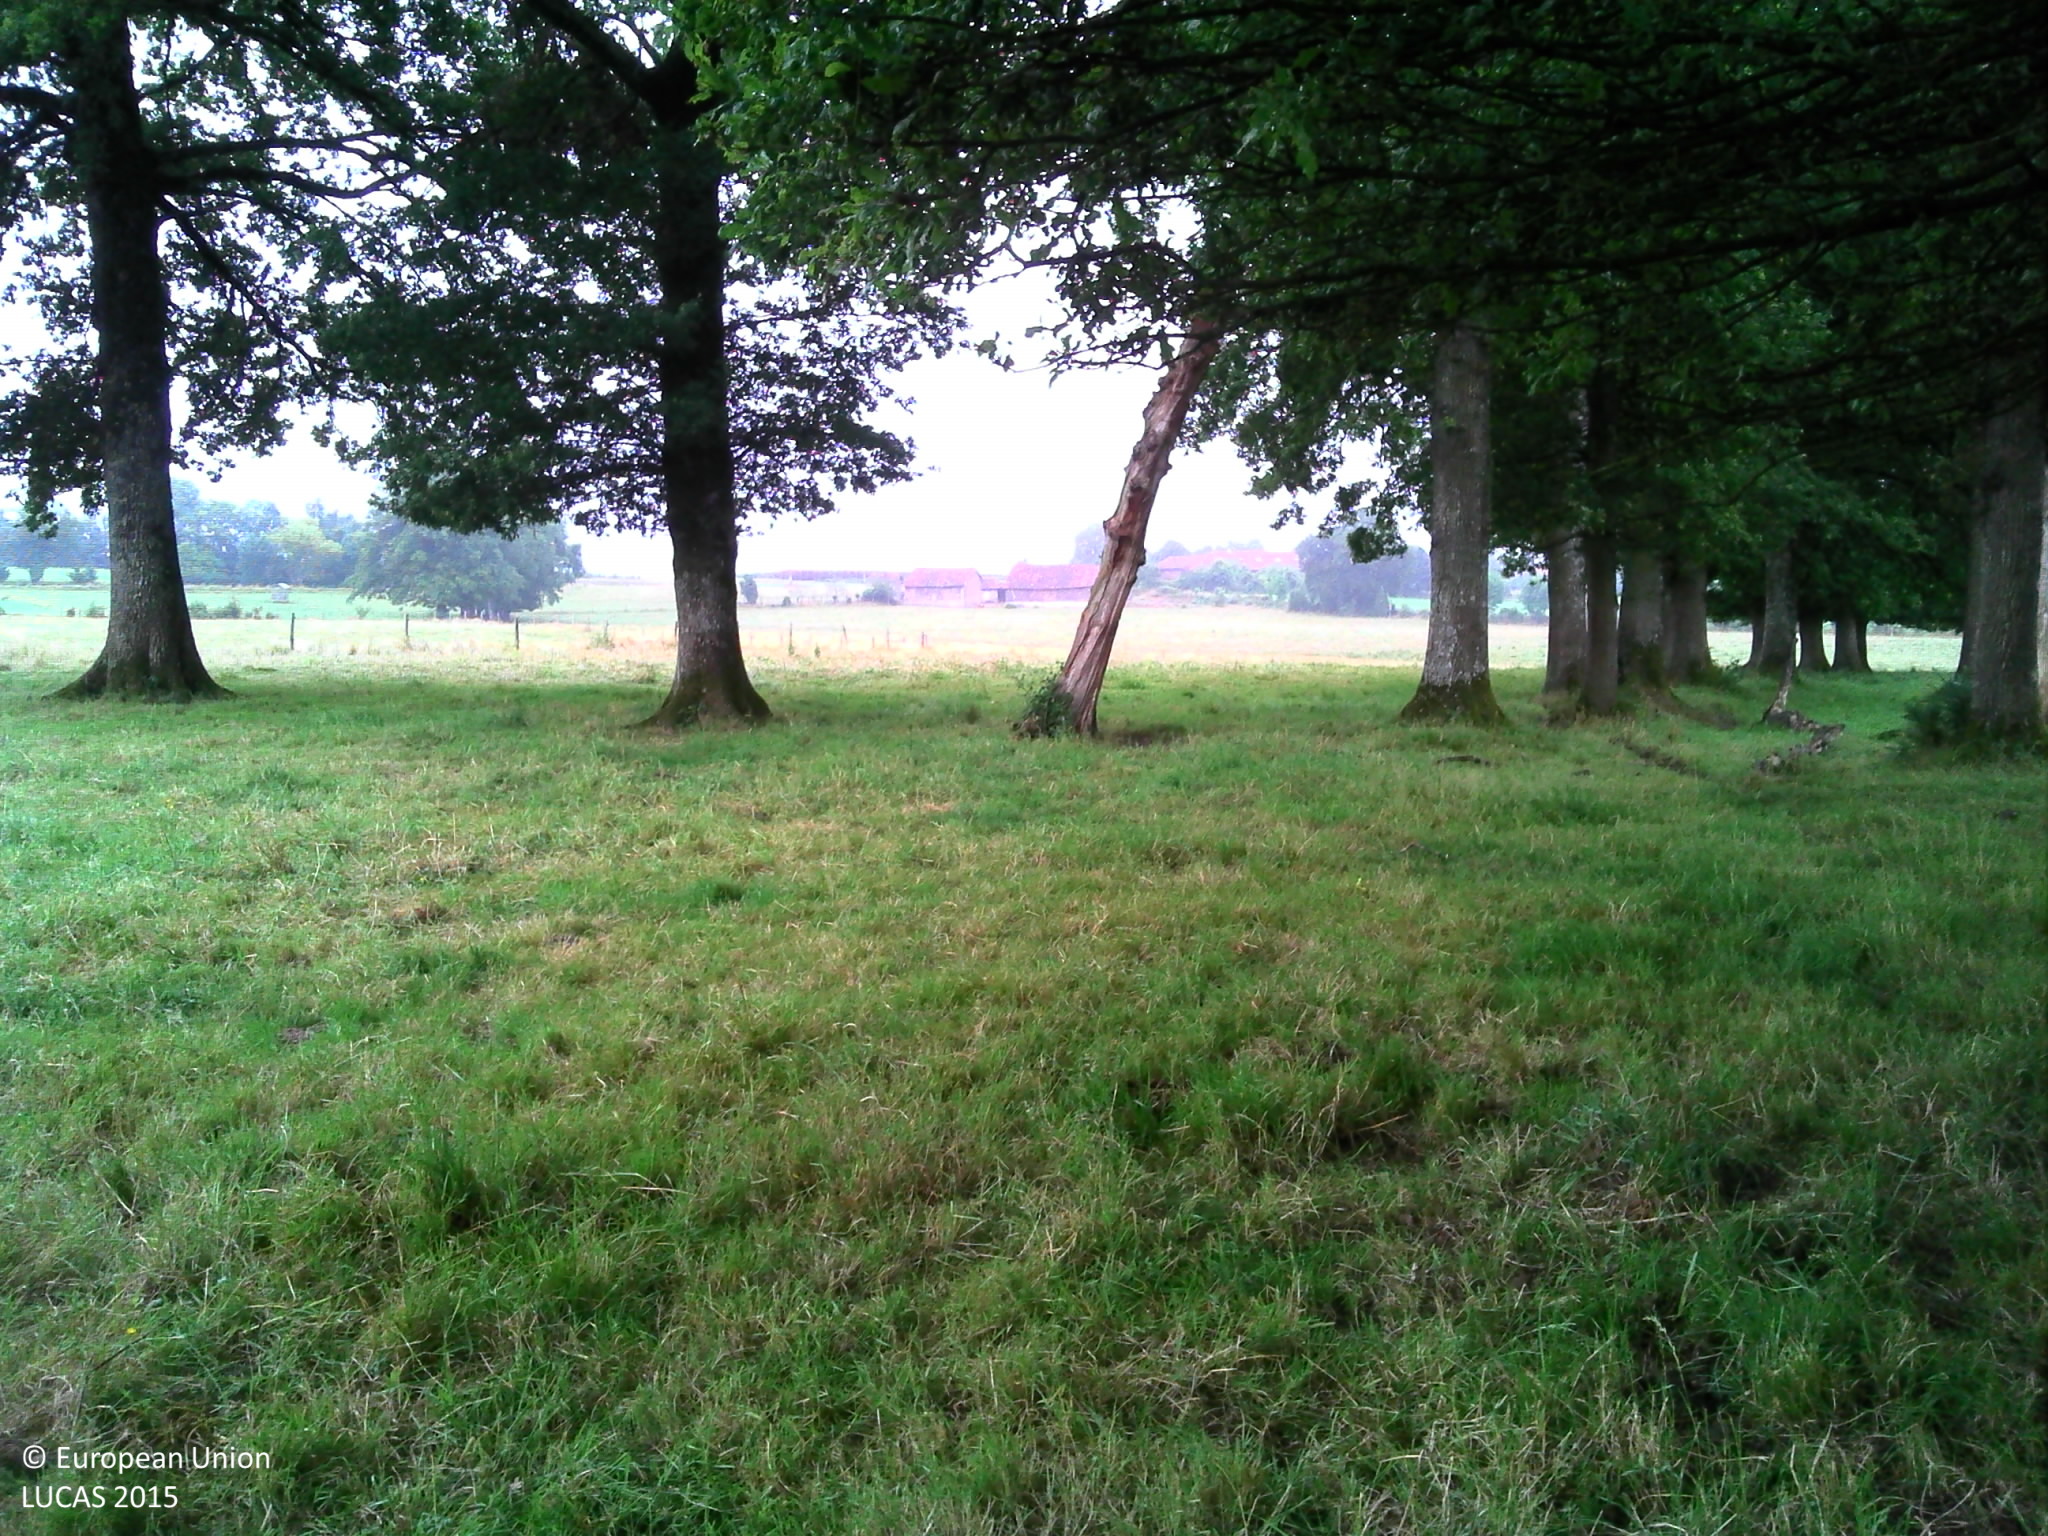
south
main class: Grassland
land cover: Grassland with sparse tree/shrub cover
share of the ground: > 75 %
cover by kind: herbaceous plants 95 %, coniferous forest trees 5 %
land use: Agriculture (excluding fallow land and kitchen gardens)
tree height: > 5 m
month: June
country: FR
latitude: 45.7899
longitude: 0.5828
